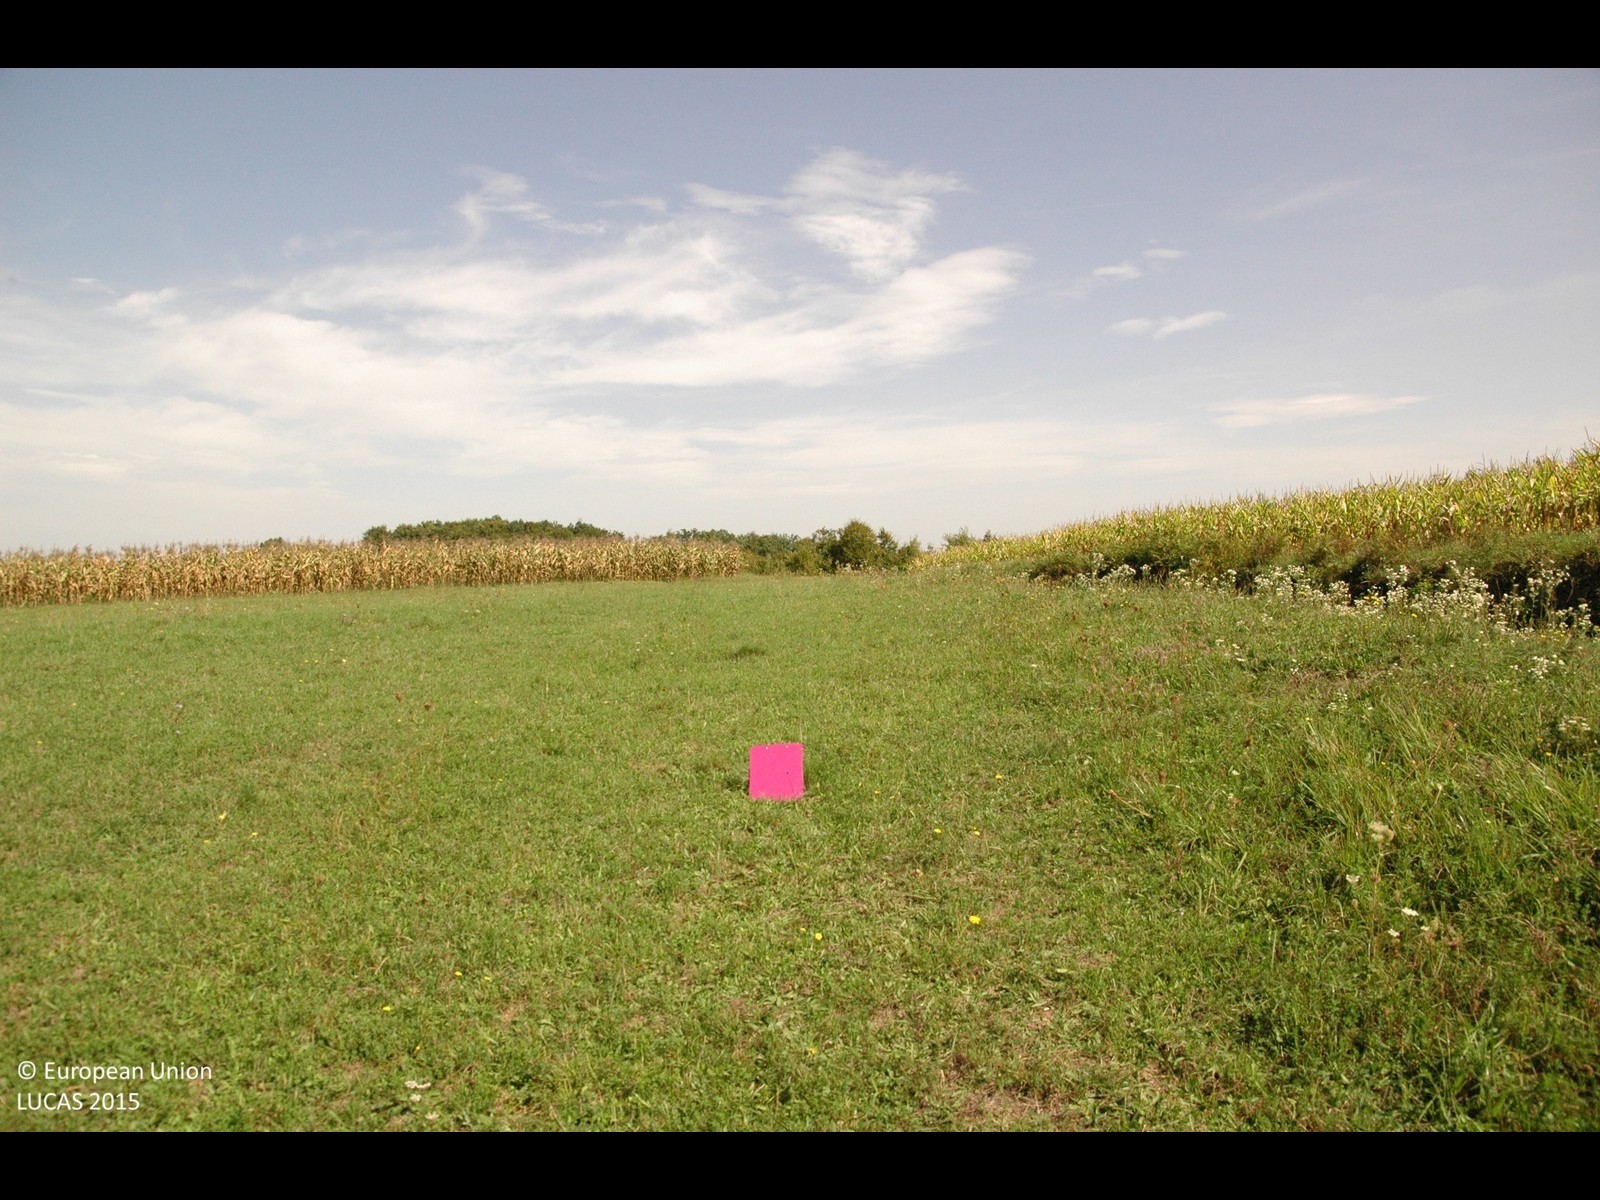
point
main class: Grassland
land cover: Grassland without tree/shrub cover
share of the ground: > 75 %
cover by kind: herbaceous plants 100 %
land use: Agriculture (excluding fallow land and kitchen gardens)
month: September
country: HR
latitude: 45.5560
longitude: 15.9026
